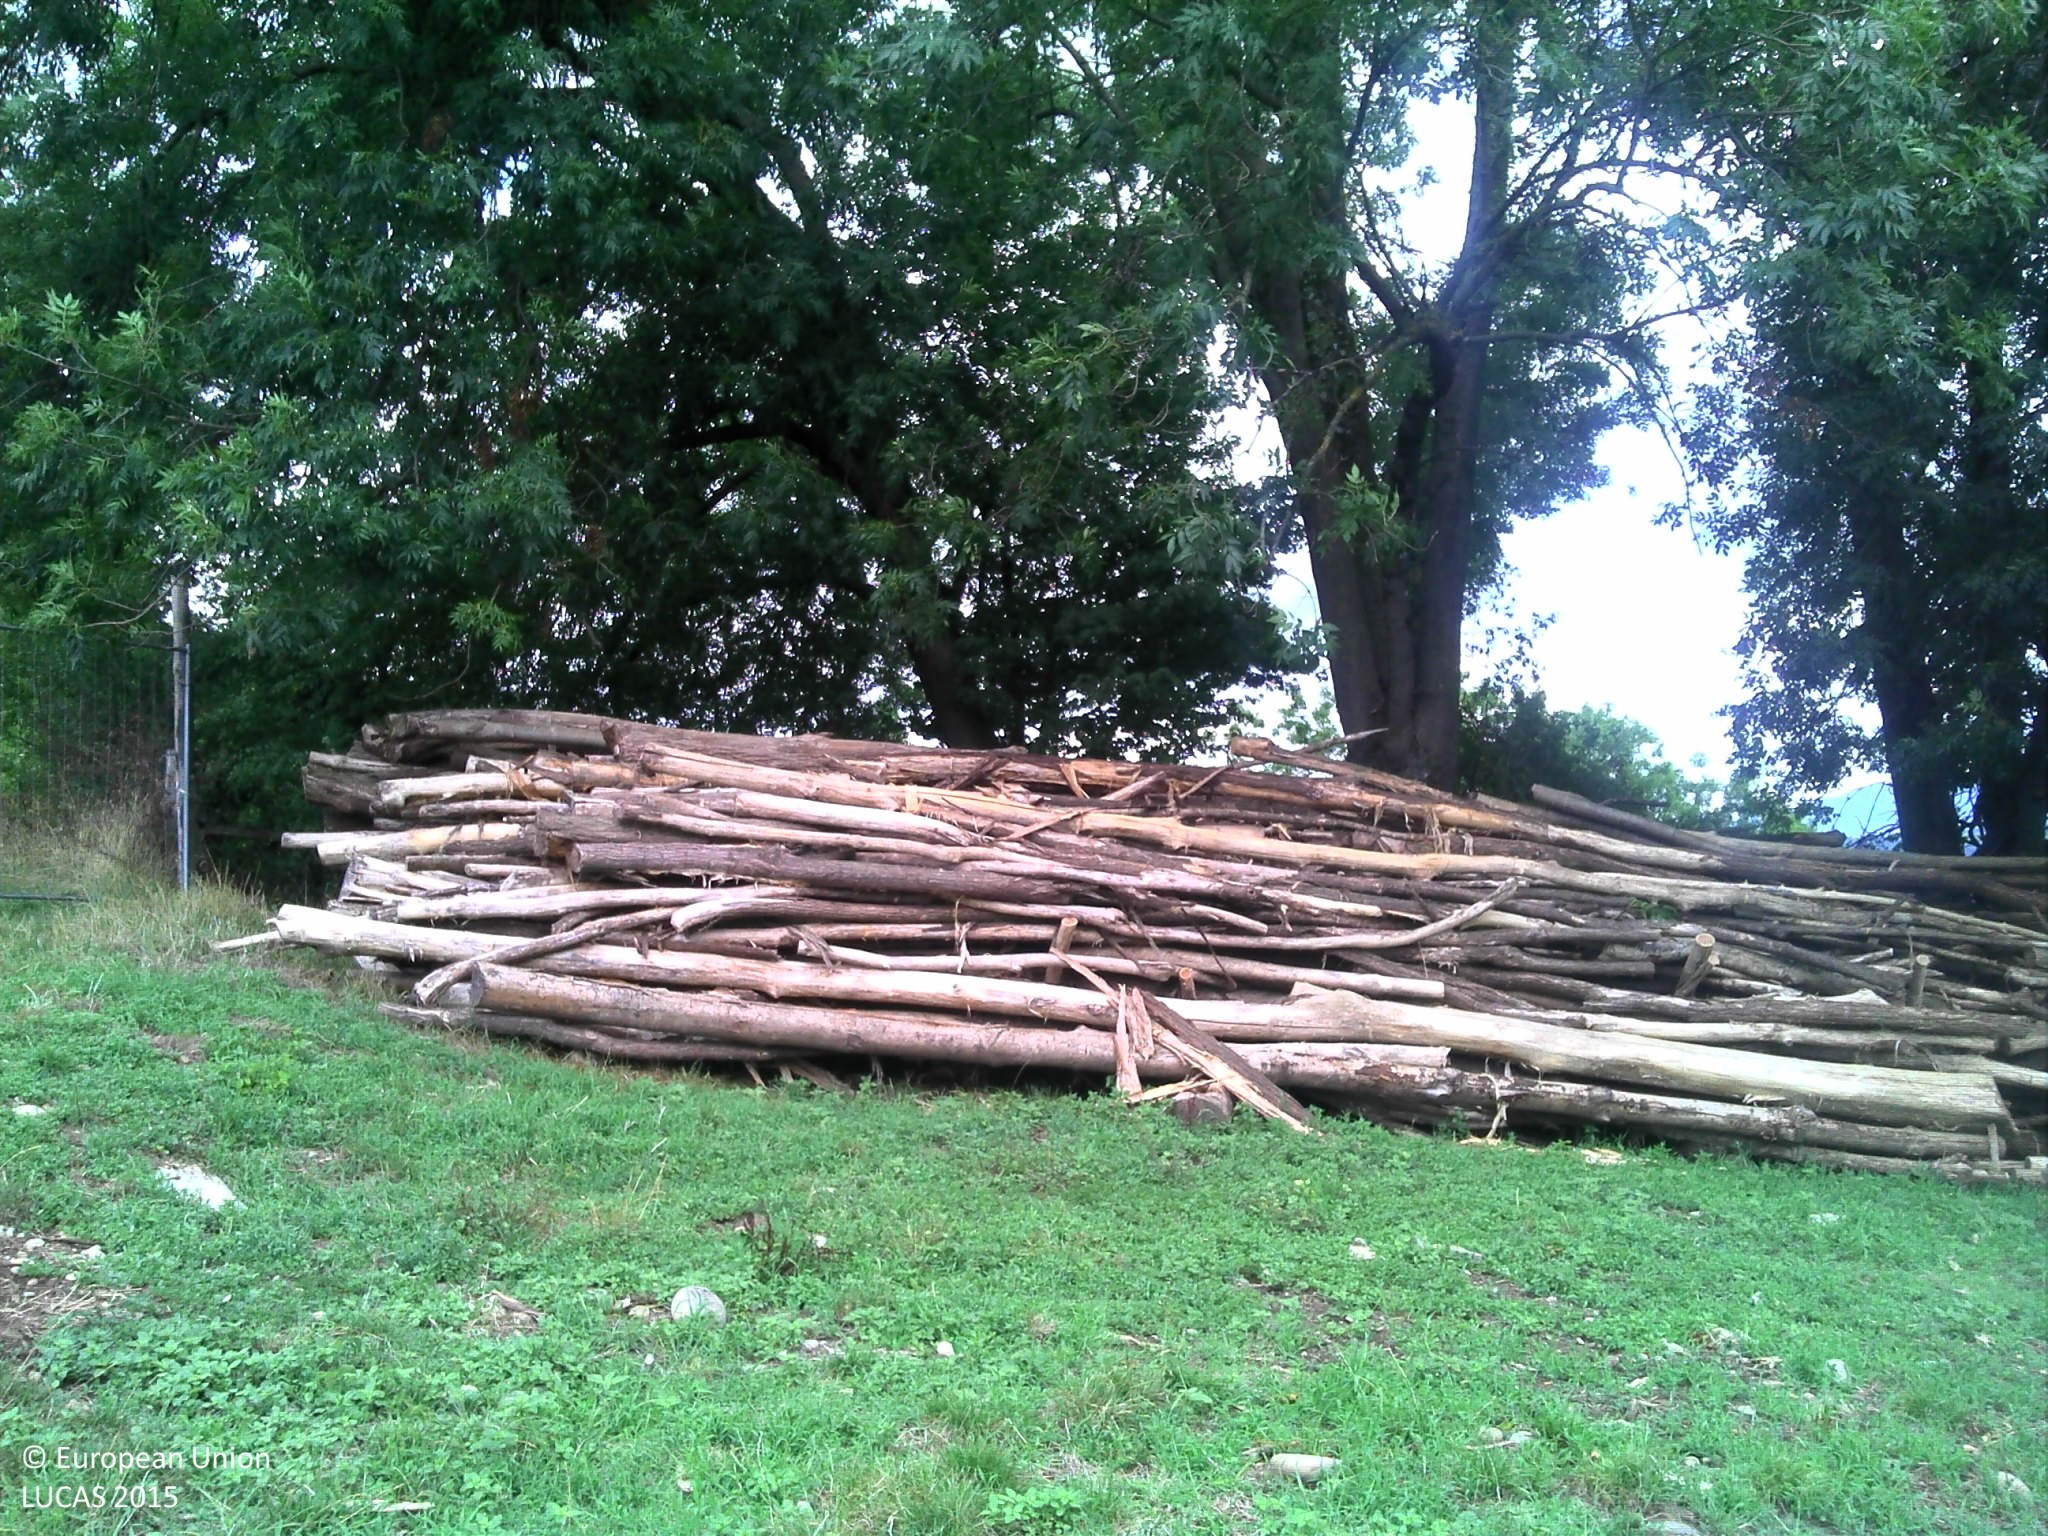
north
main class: Grassland
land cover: Grassland without tree/shrub cover
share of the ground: > 75 %
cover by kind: herbaceous plants 95 %, shrubs 5 %
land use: Agriculture (excluding fallow land and kitchen gardens)
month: August
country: FR
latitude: 45.2813
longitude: 5.4795
